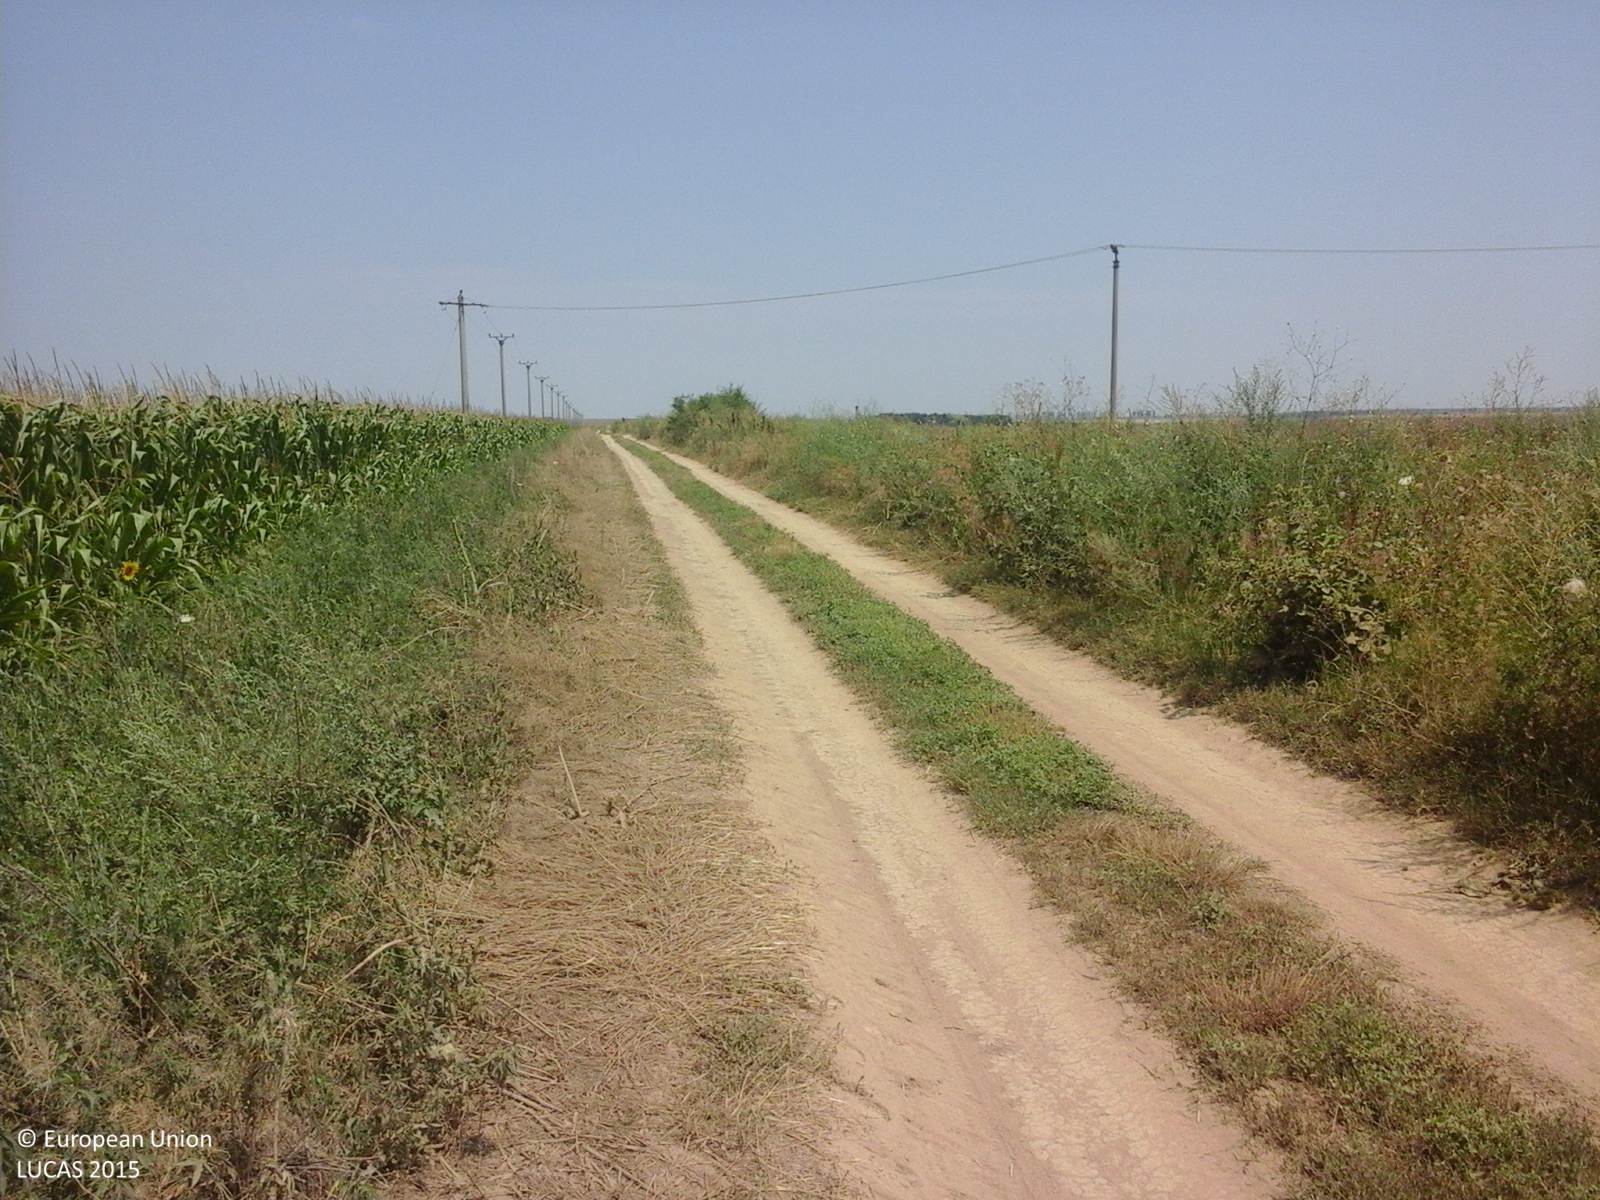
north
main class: Cropland
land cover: Maize
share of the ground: > 75 %
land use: Agriculture (excluding fallow land and kitchen gardens)
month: July
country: RO
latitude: 44.6621
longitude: 27.5637
